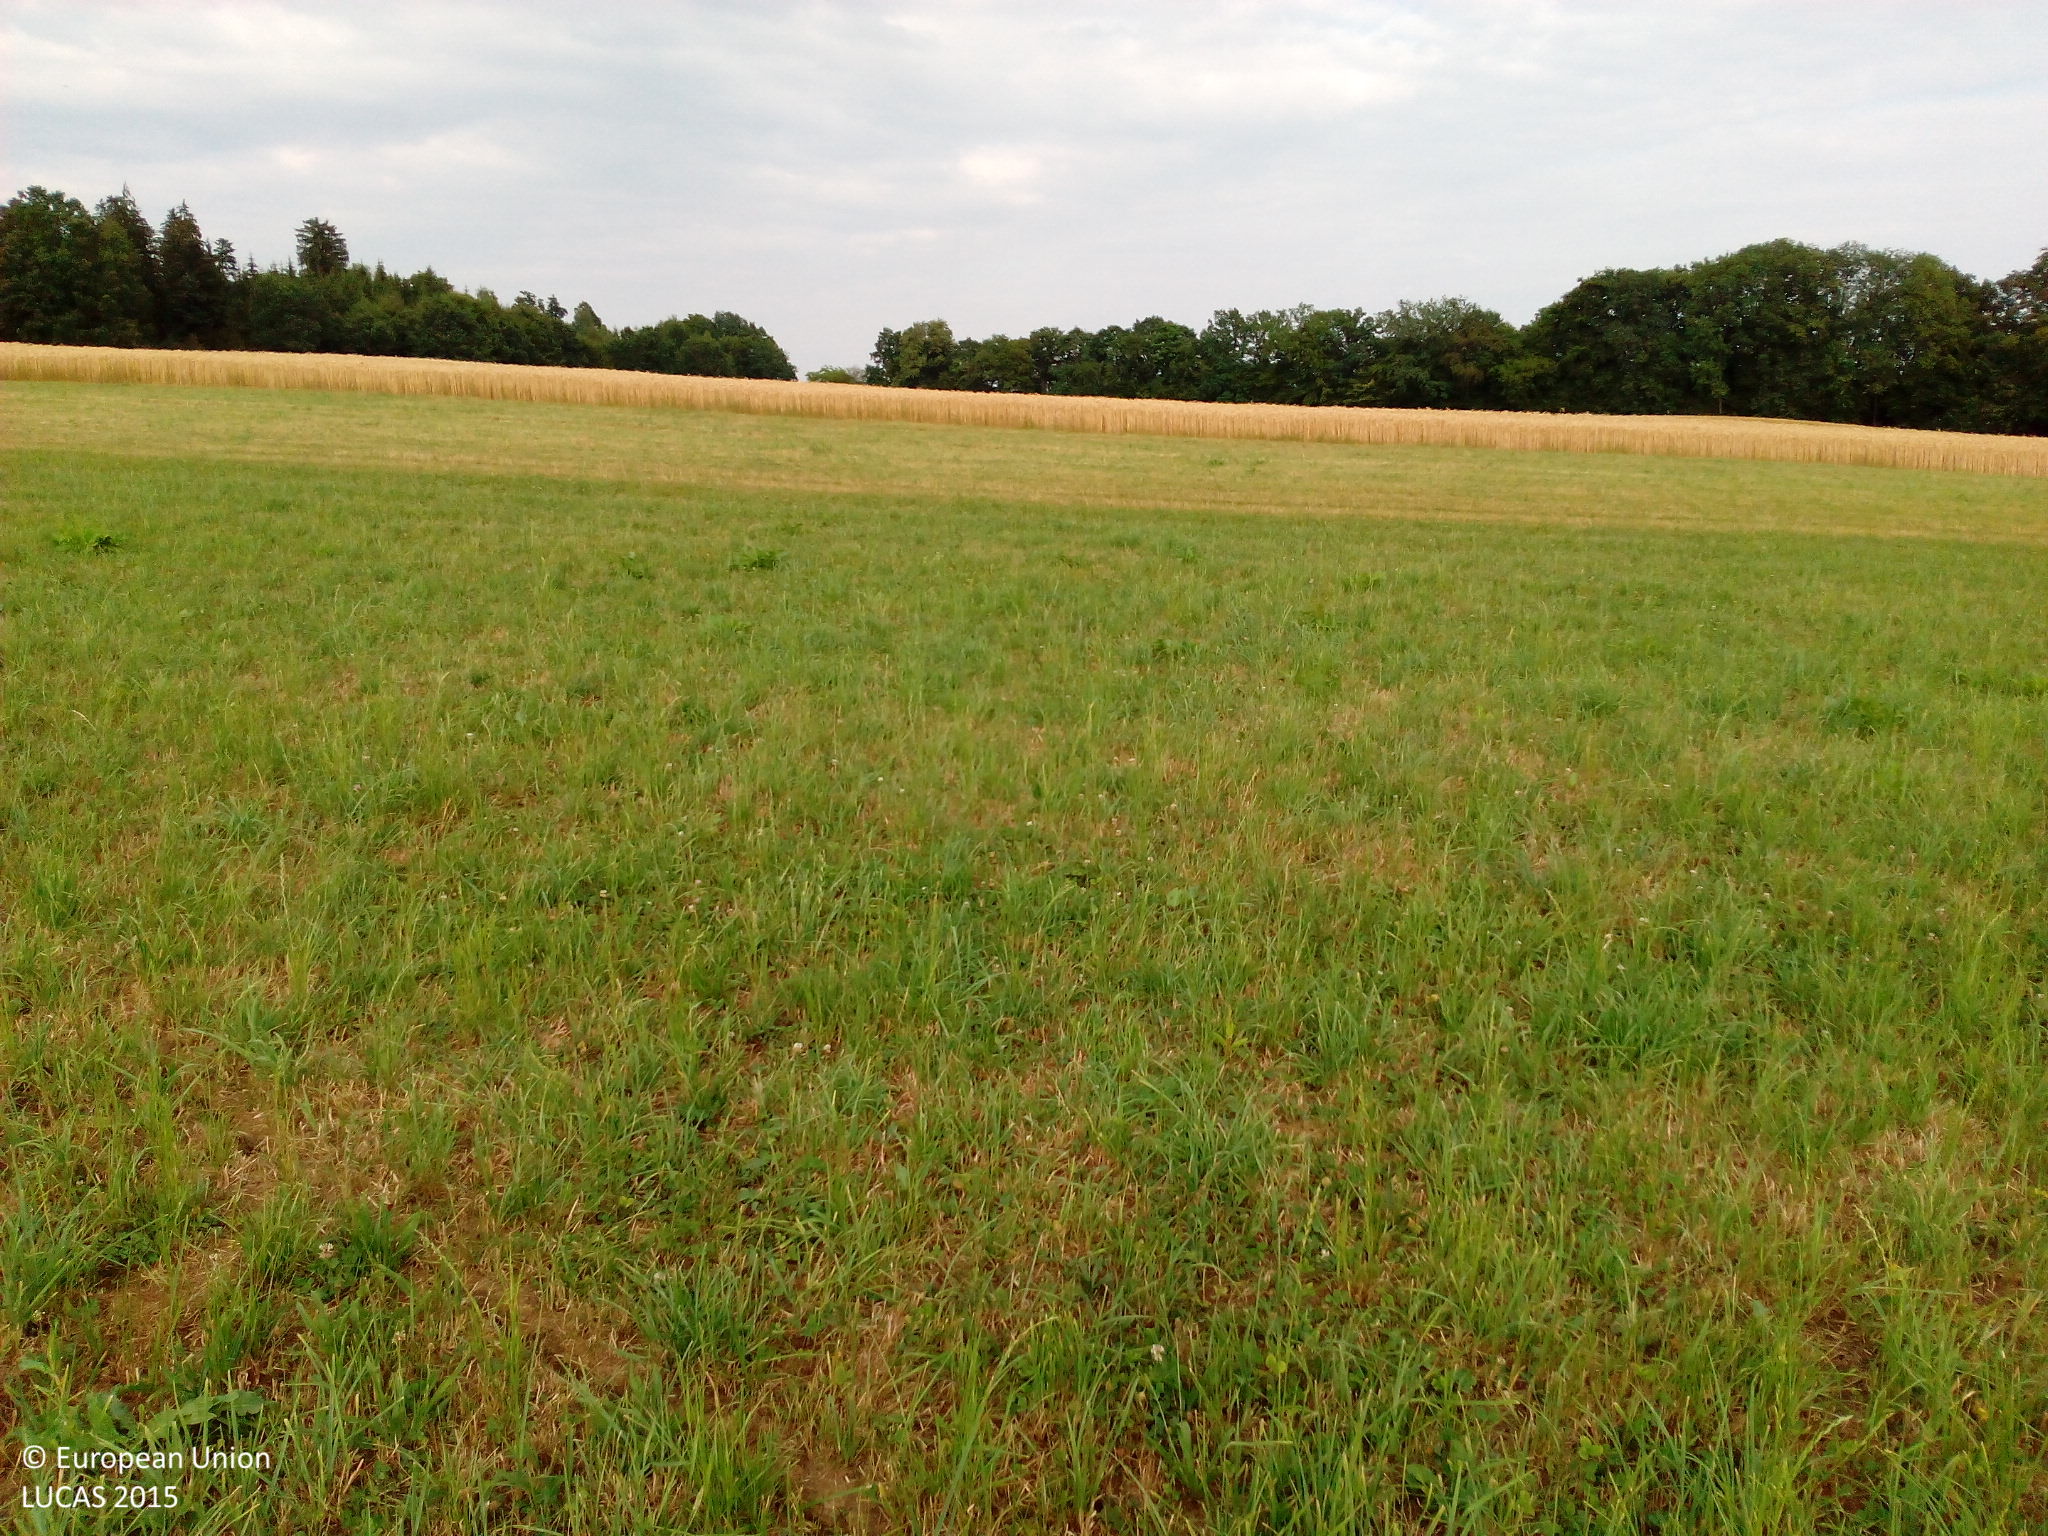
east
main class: Grassland
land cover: Grassland without tree/shrub cover
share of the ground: > 75 %
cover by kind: herbaceous plants 80 %, unconsolidated bare surface 20 %
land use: Agriculture (excluding fallow land and kitchen gardens)
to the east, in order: Grassland without tree/shrub cover; Rye; Temporary grasslands; Oats
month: July
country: DE
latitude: 48.8713
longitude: 9.9591
